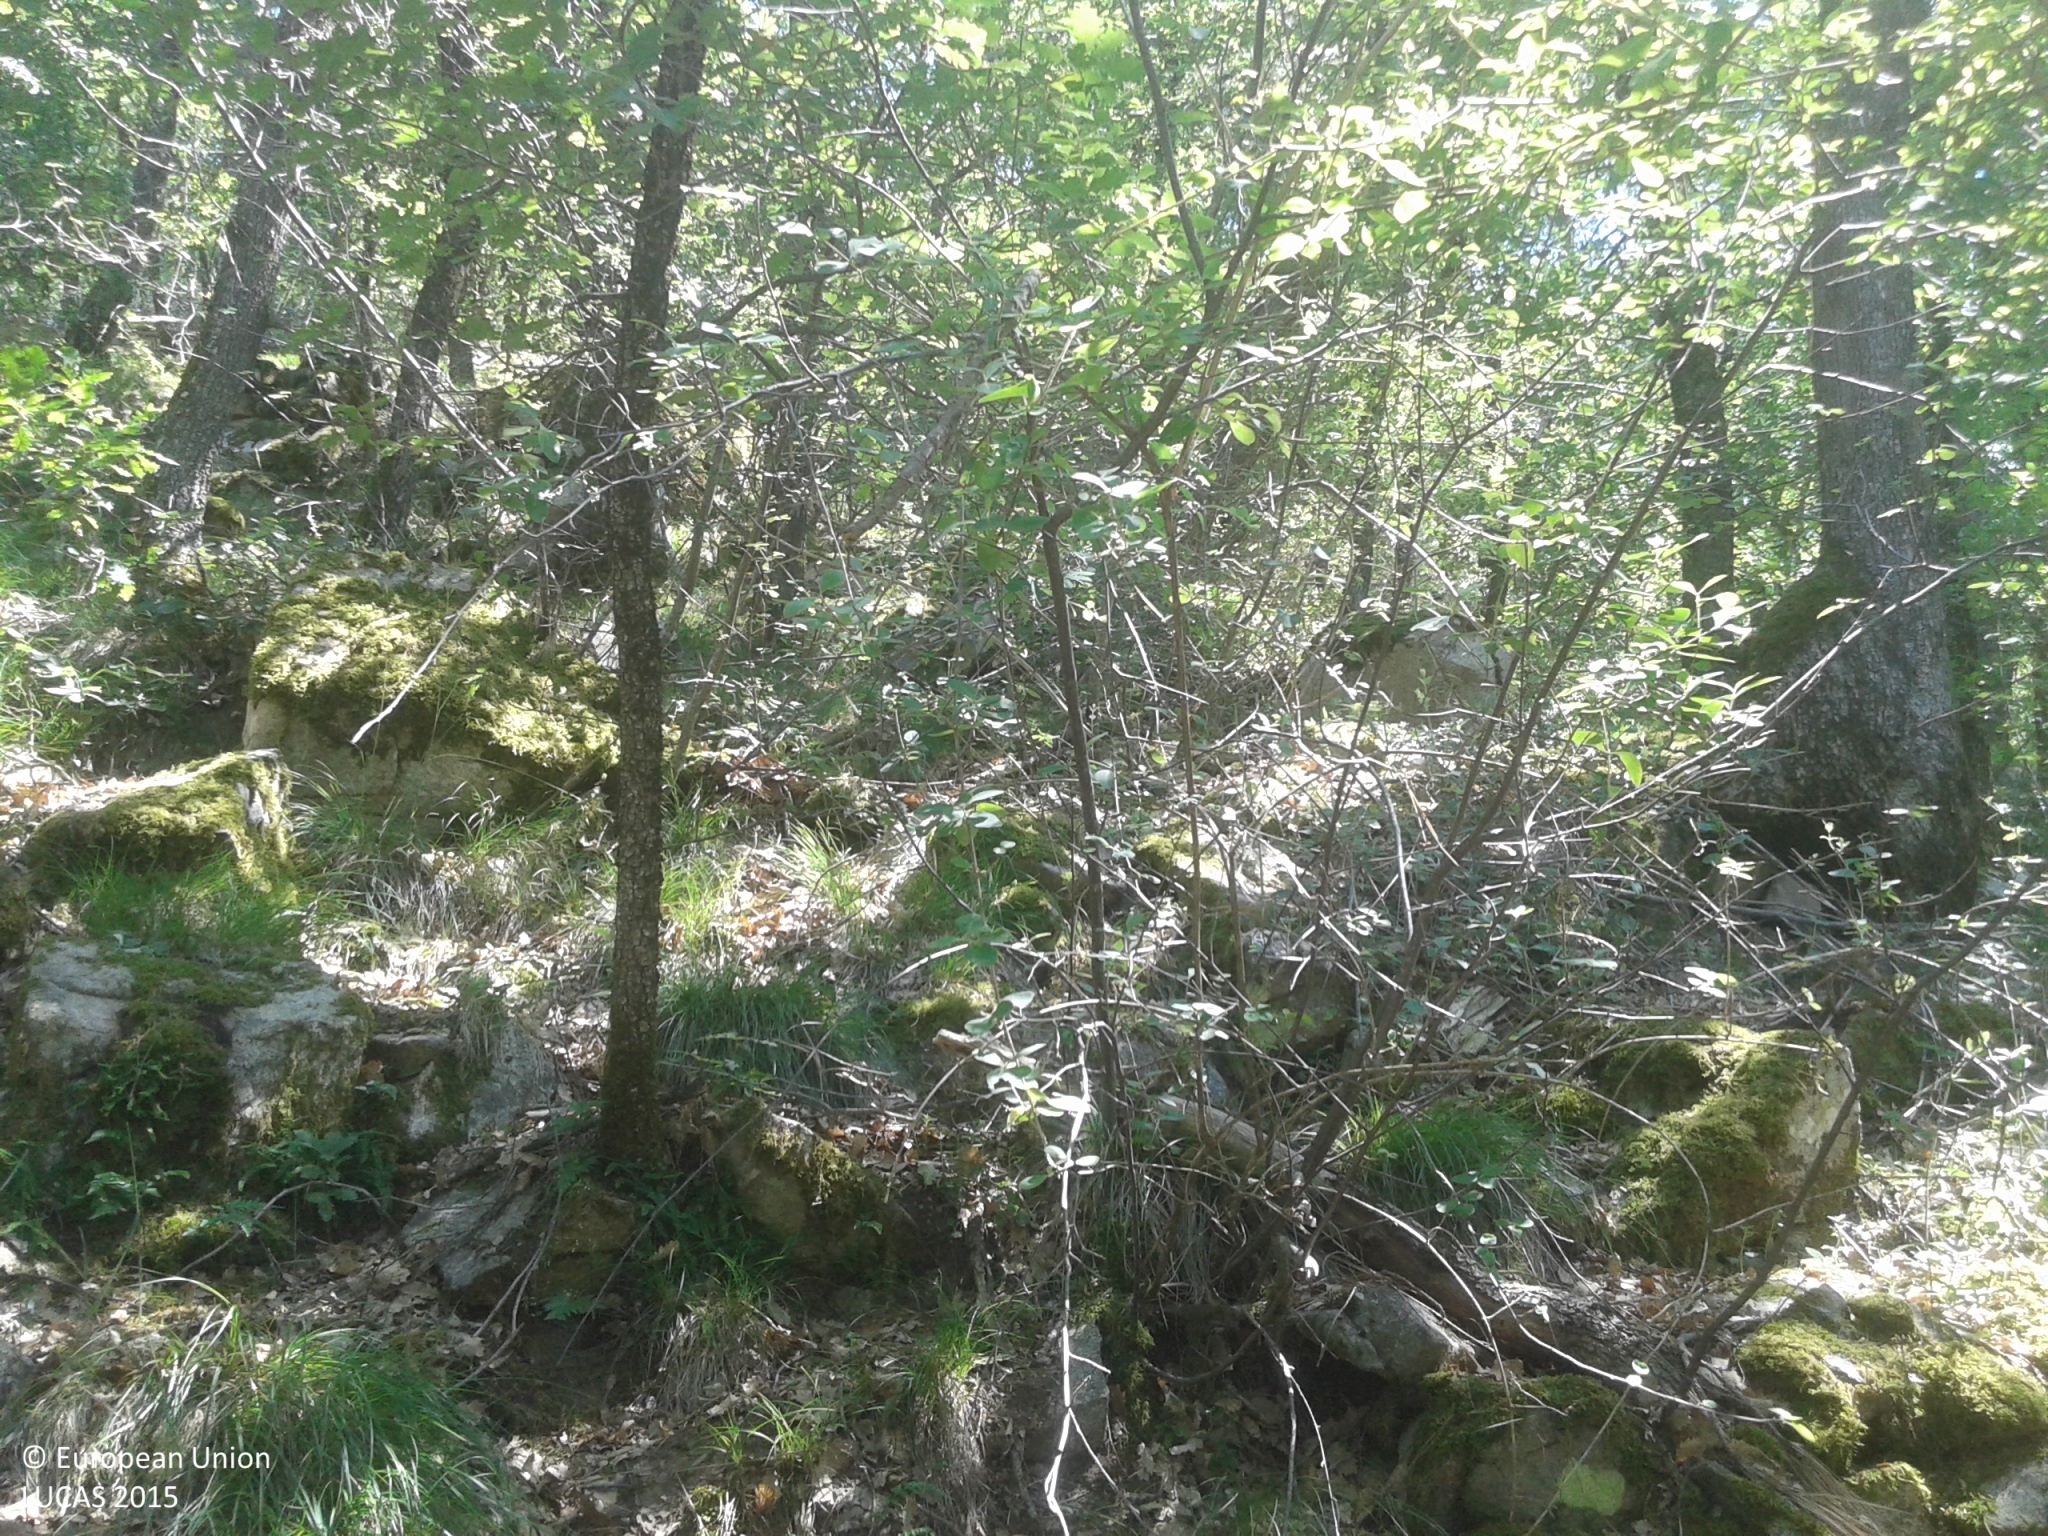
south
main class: Woodland
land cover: Other mixed woodland
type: coniferous forest of the mediterranean region
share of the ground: > 75 %
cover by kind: broadleaved forest trees 55 %, coniferous forest trees 35 %, herbaceous plants 5 %, lichens and mosses 5 %
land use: Semi-natural and natural areas not in use
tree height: > 5 m
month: June
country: ES
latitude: 42.3567
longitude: 1.5725
